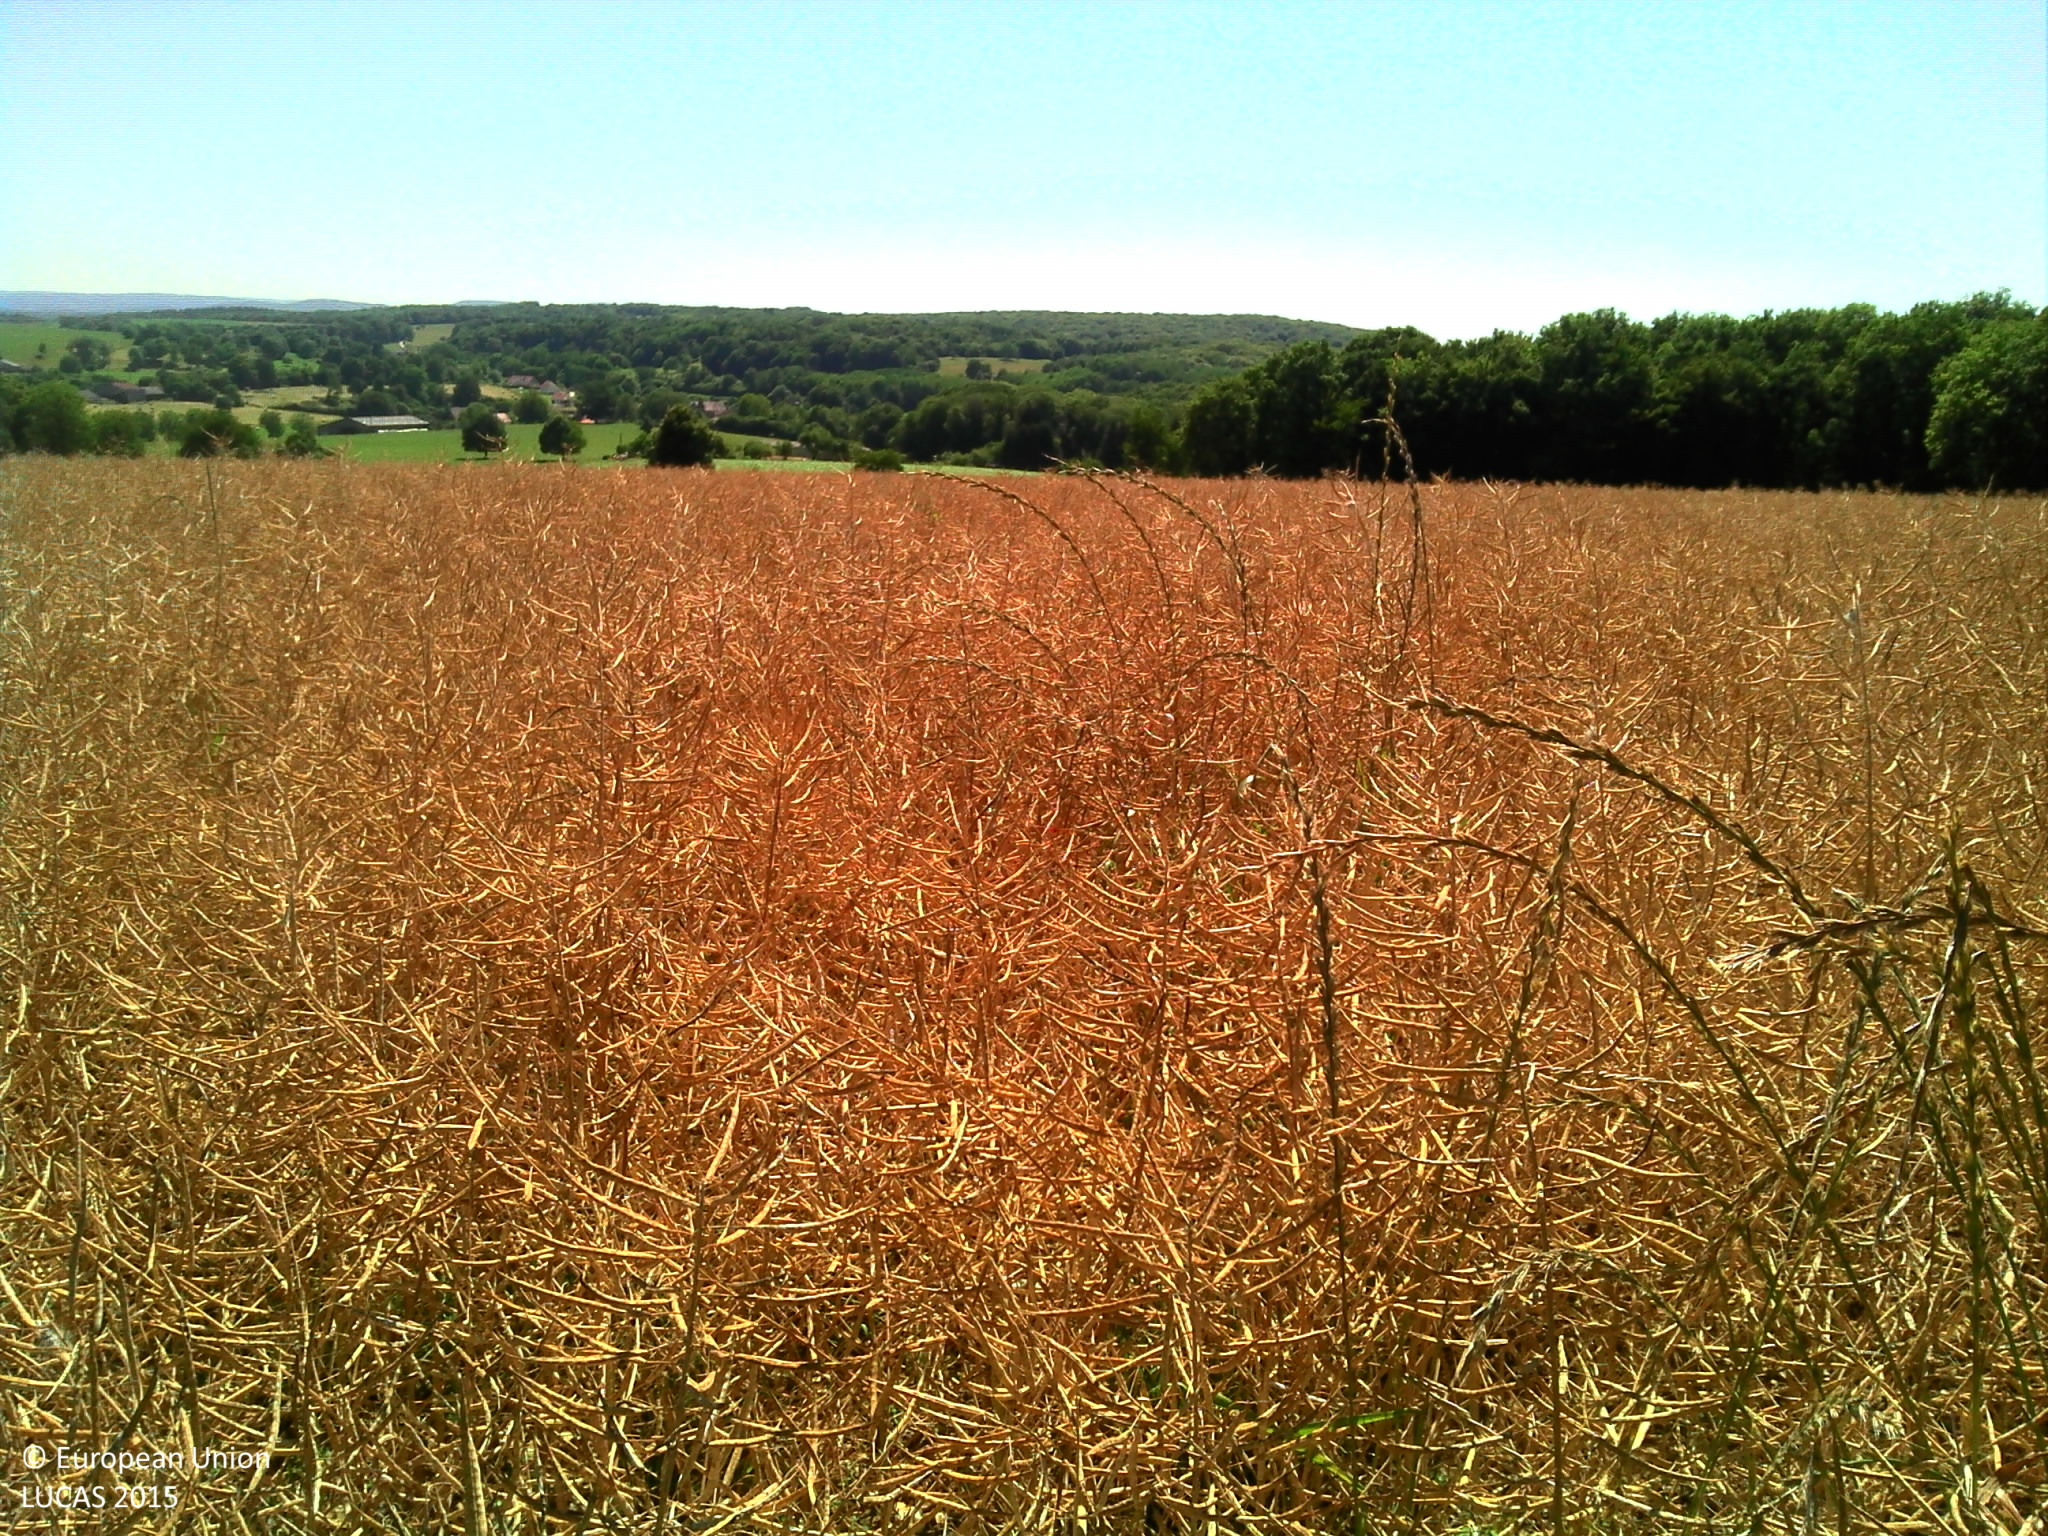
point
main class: Cropland
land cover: Rape and turnip rape
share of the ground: > 75 %
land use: Agriculture (excluding fallow land and kitchen gardens)
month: June
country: FR
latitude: 47.4930
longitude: 6.2451
